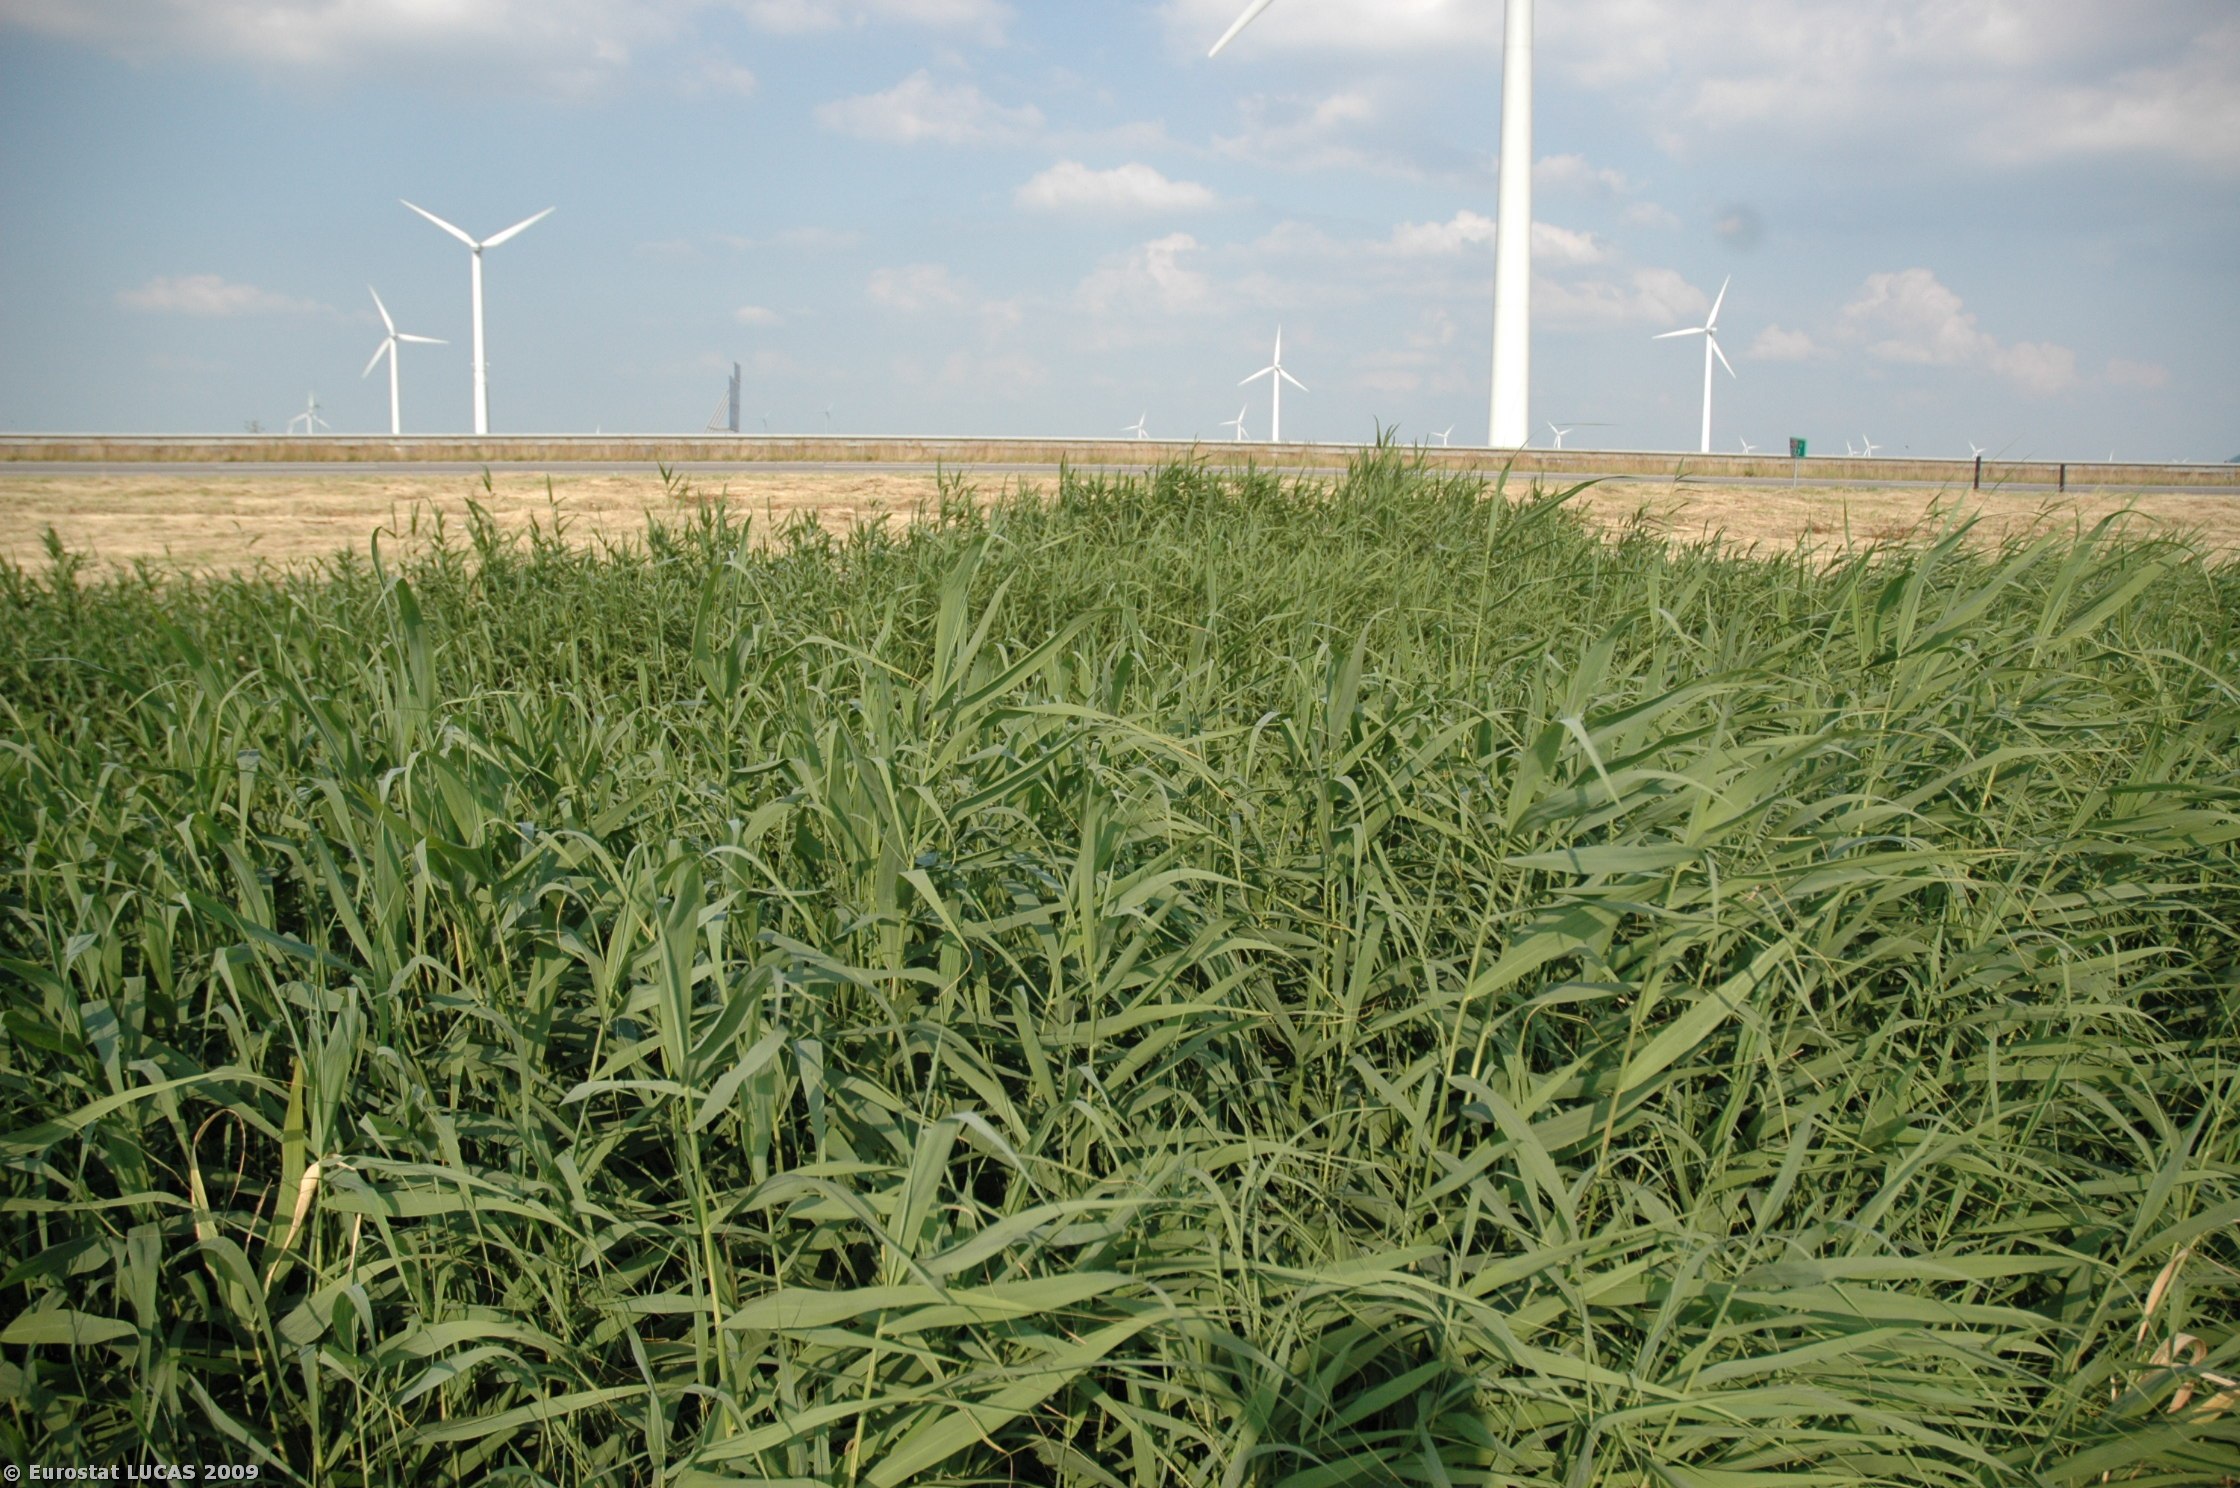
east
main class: Grassland
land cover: Grassland without tree/shrub cover
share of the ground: > 75 %
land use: Agriculture (excluding fallow land and kitchen gardens)
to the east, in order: Grassland without tree/shrub cover; Inland marshes; Inland running water; Inland marshes; Grassland without tree/shrub cover; Paved roads, cycling and walking lanes; Grass margins; Paved roads, cycling and walking lanes; Grassland without tree/shrub cover; Ditches and canals; Grassland without tree/shrub cover; Ditches and canals; Grassland without tree/shrub cover; Tracks; Grassland without tree/shrub cover; Inland marshes; Inland running water
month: June
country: NL
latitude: 52.3403
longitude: 5.3453
